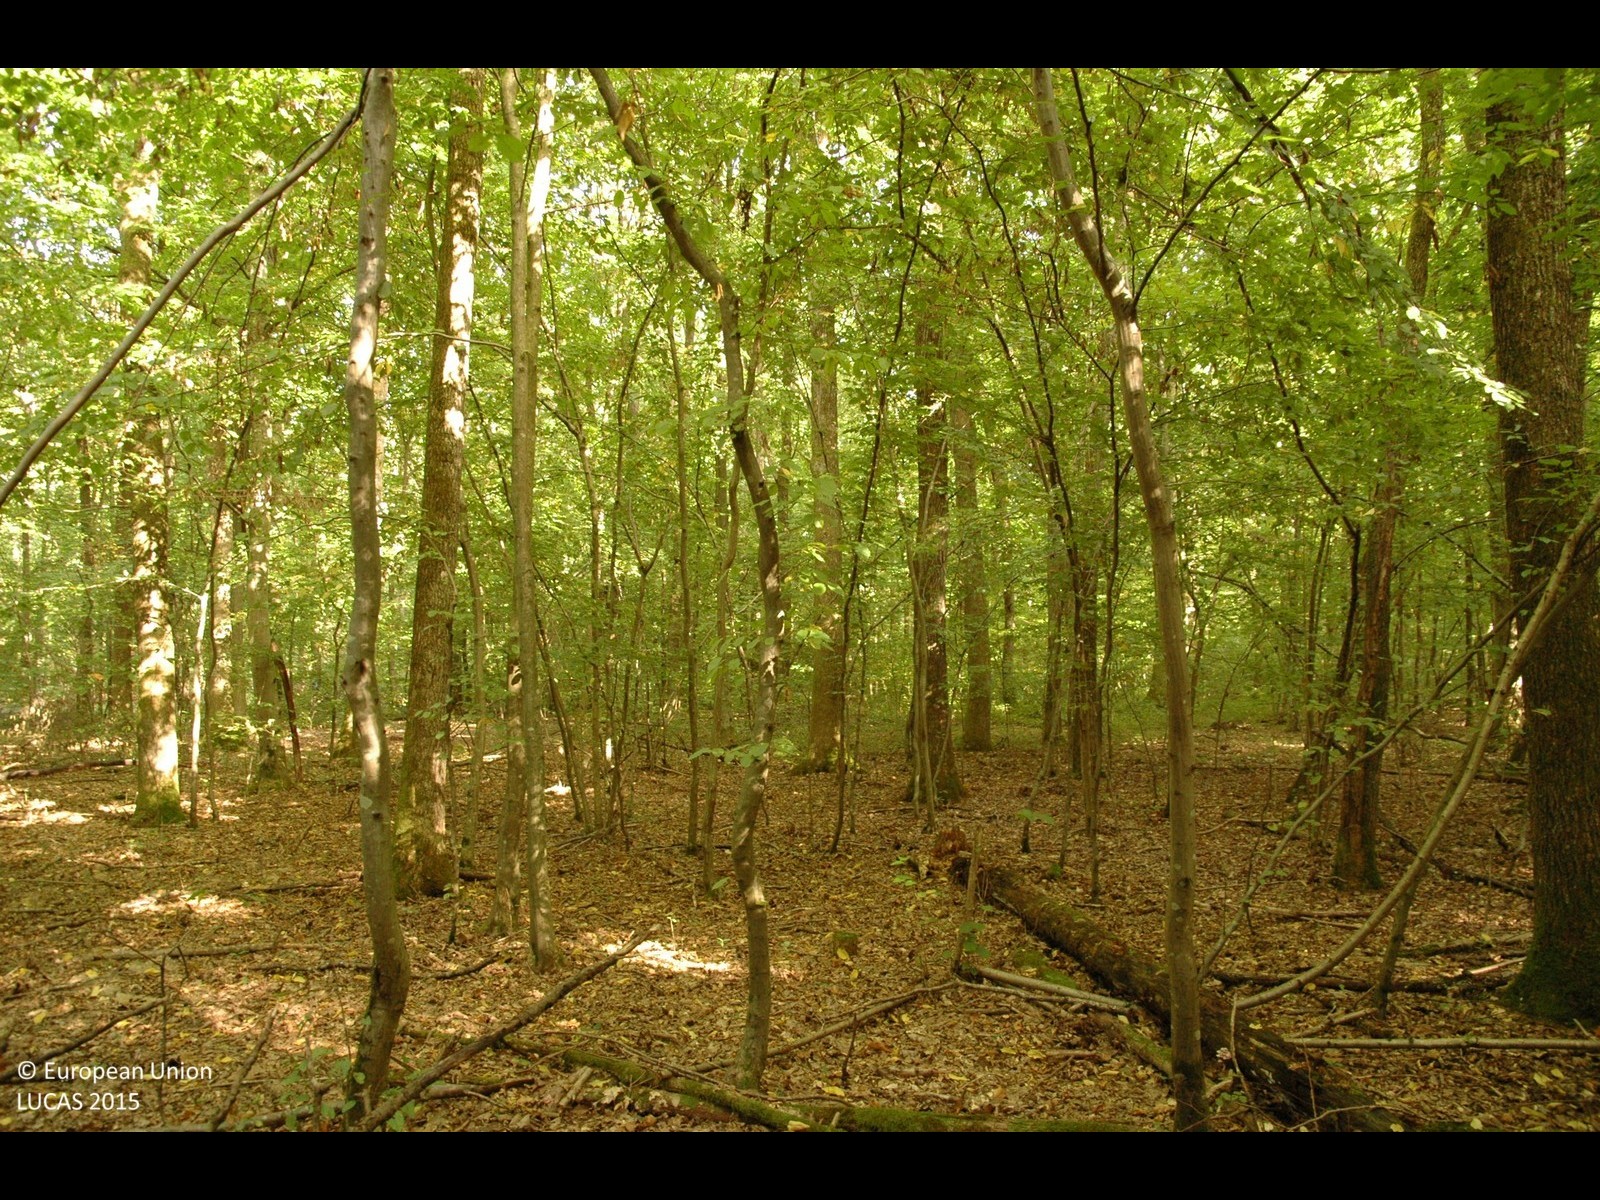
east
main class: Woodland
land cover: Broadleaved woodland
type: mesophytic deciduous forest
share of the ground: > 75 %
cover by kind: broadleaved forest trees 100 %
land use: Forestry
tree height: > 5 m
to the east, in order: Broadleaved woodland
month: September
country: HR
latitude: 45.6803
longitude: 15.9418
